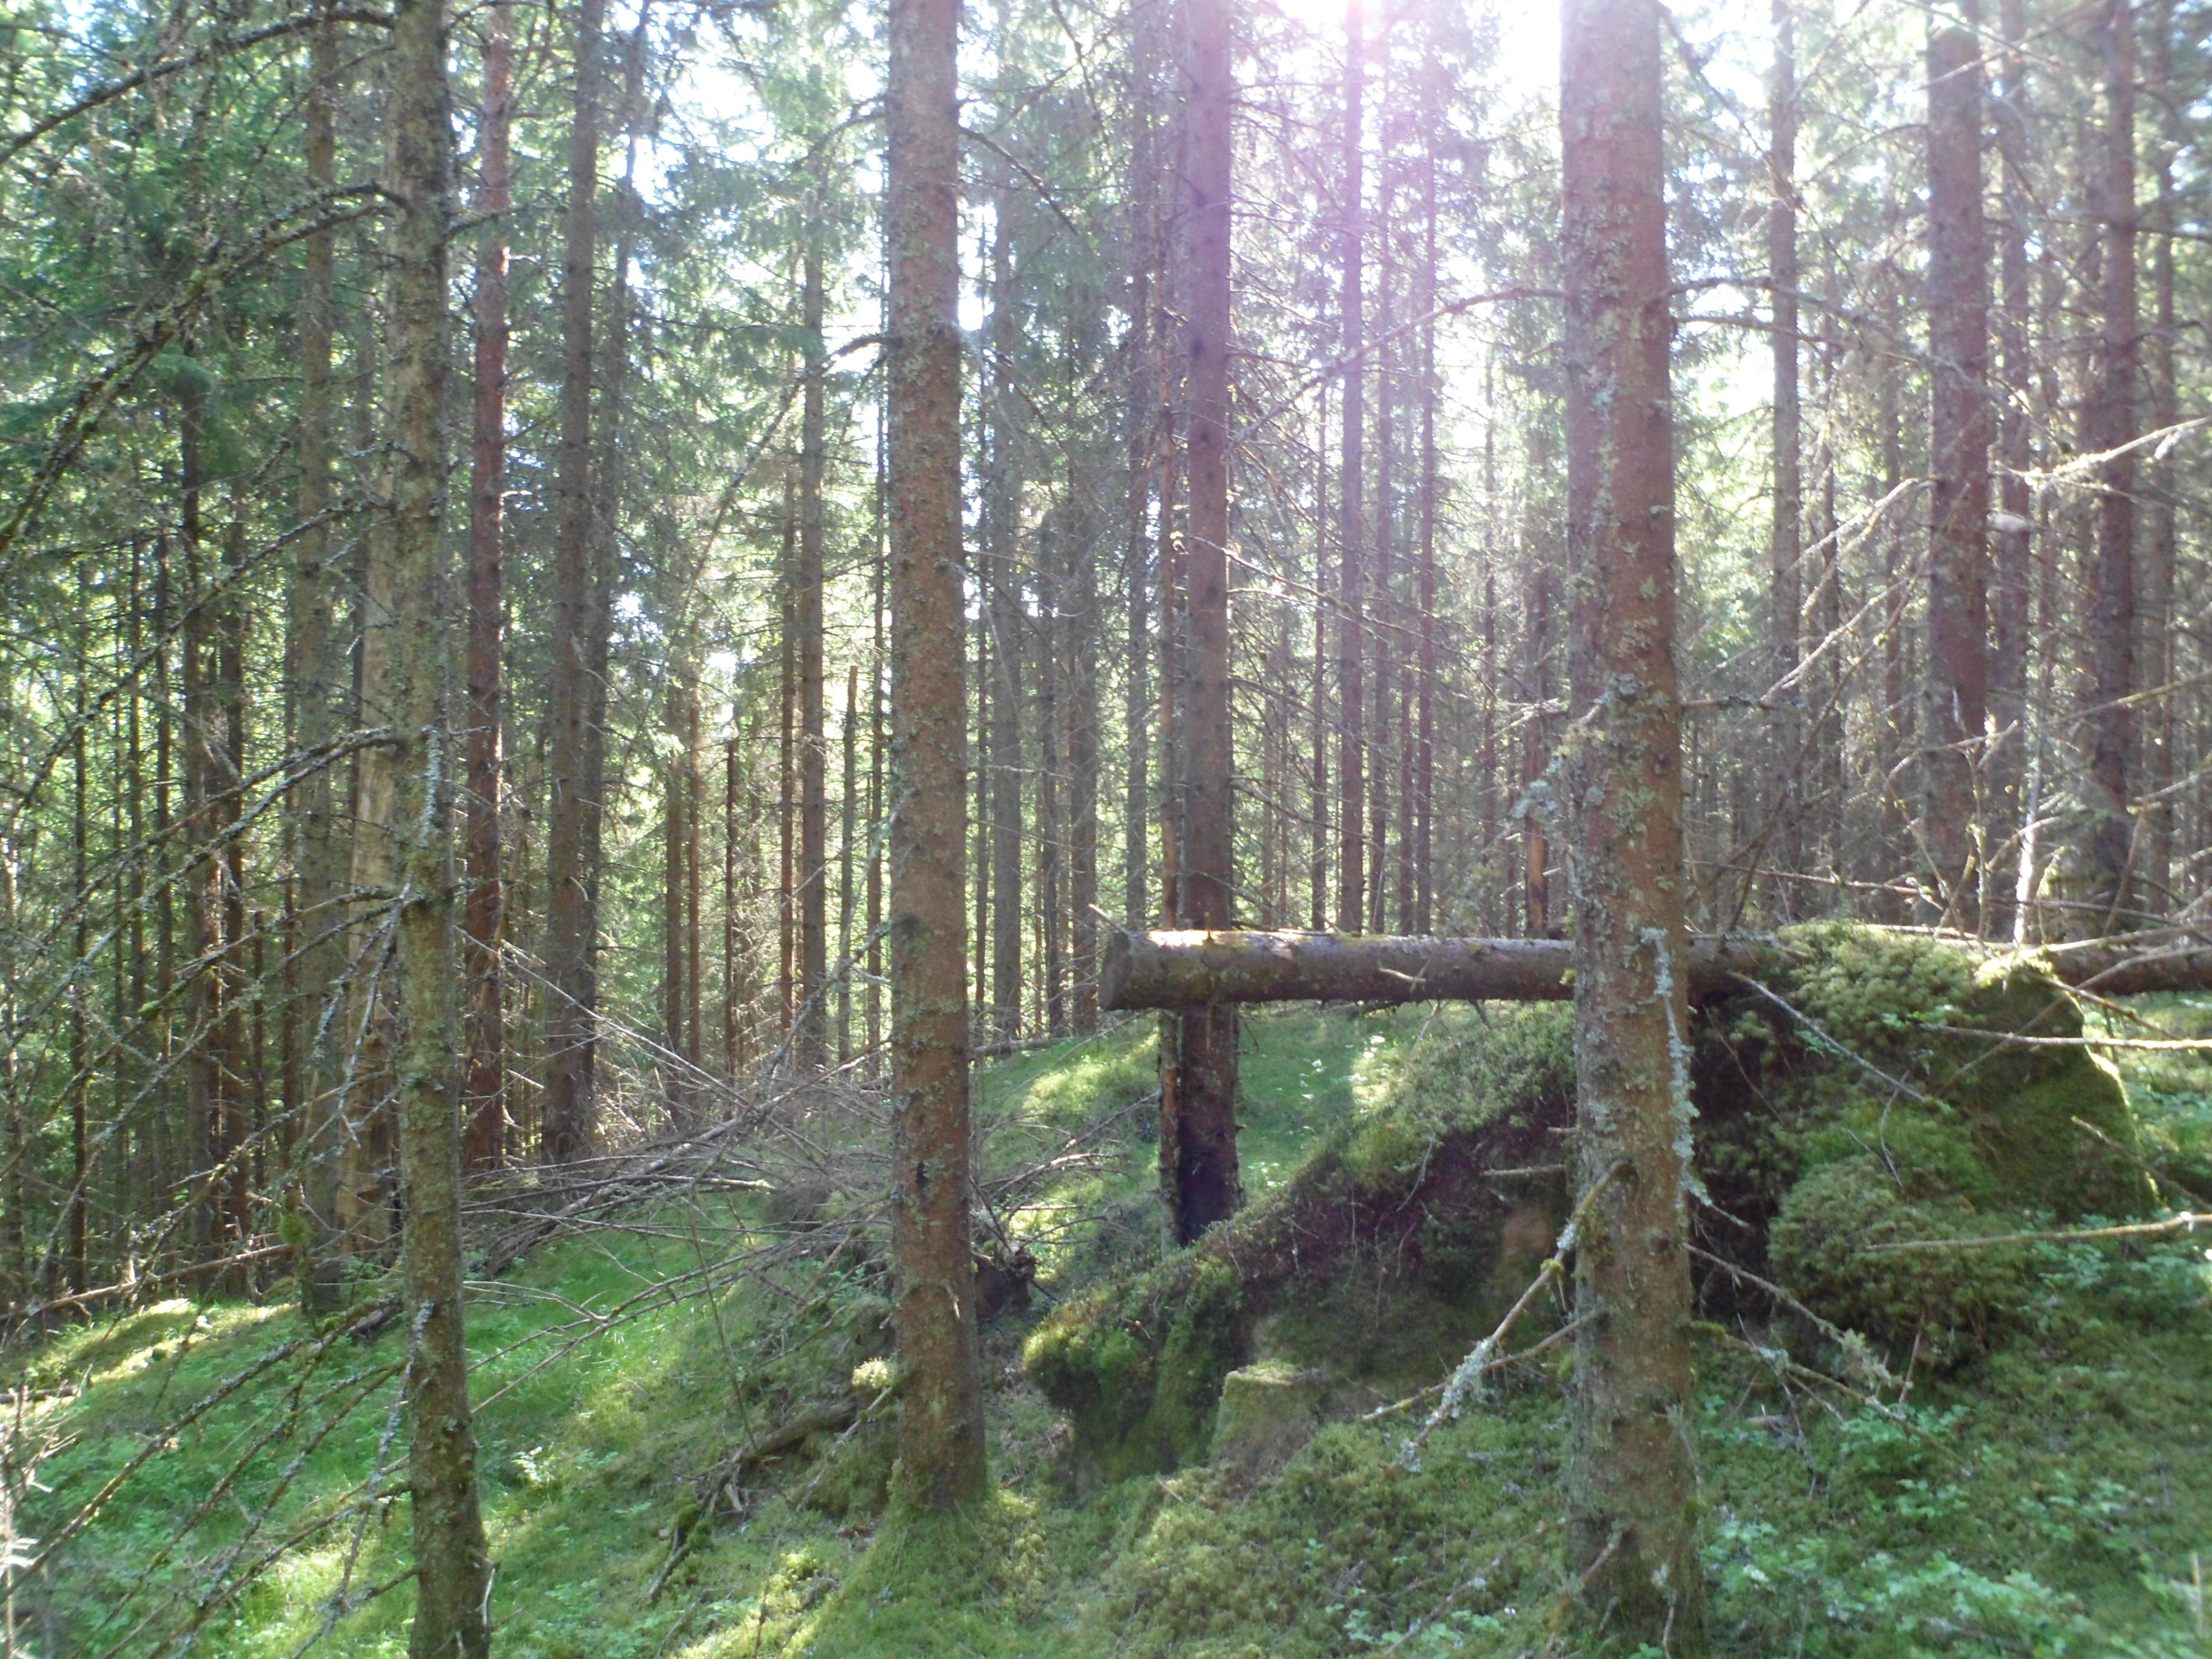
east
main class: Woodland
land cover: Spruce dominated coniferous woodland
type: boreal forest
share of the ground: 50 - 75 %
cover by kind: coniferous forest trees 70 %, lichens and mosses 15 %, shrubs 10 %, herbaceous plants 5 %
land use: Forestry
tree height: > 5 m
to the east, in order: Spruce dominated coniferous woodland; Tracks; Spruce dominated mixed woodland; Grassland with sparse tree/shrub cover; Ditches and canals; Grass margins; Paved roads, cycling and walking lanes; Grassland with sparse tree/shrub cover; Electric lines; Spruce dominated coniferous woodland; Spruce dominated mixed woodland; Inland fresh running water
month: June
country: SE
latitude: 57.4603
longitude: 13.9128
